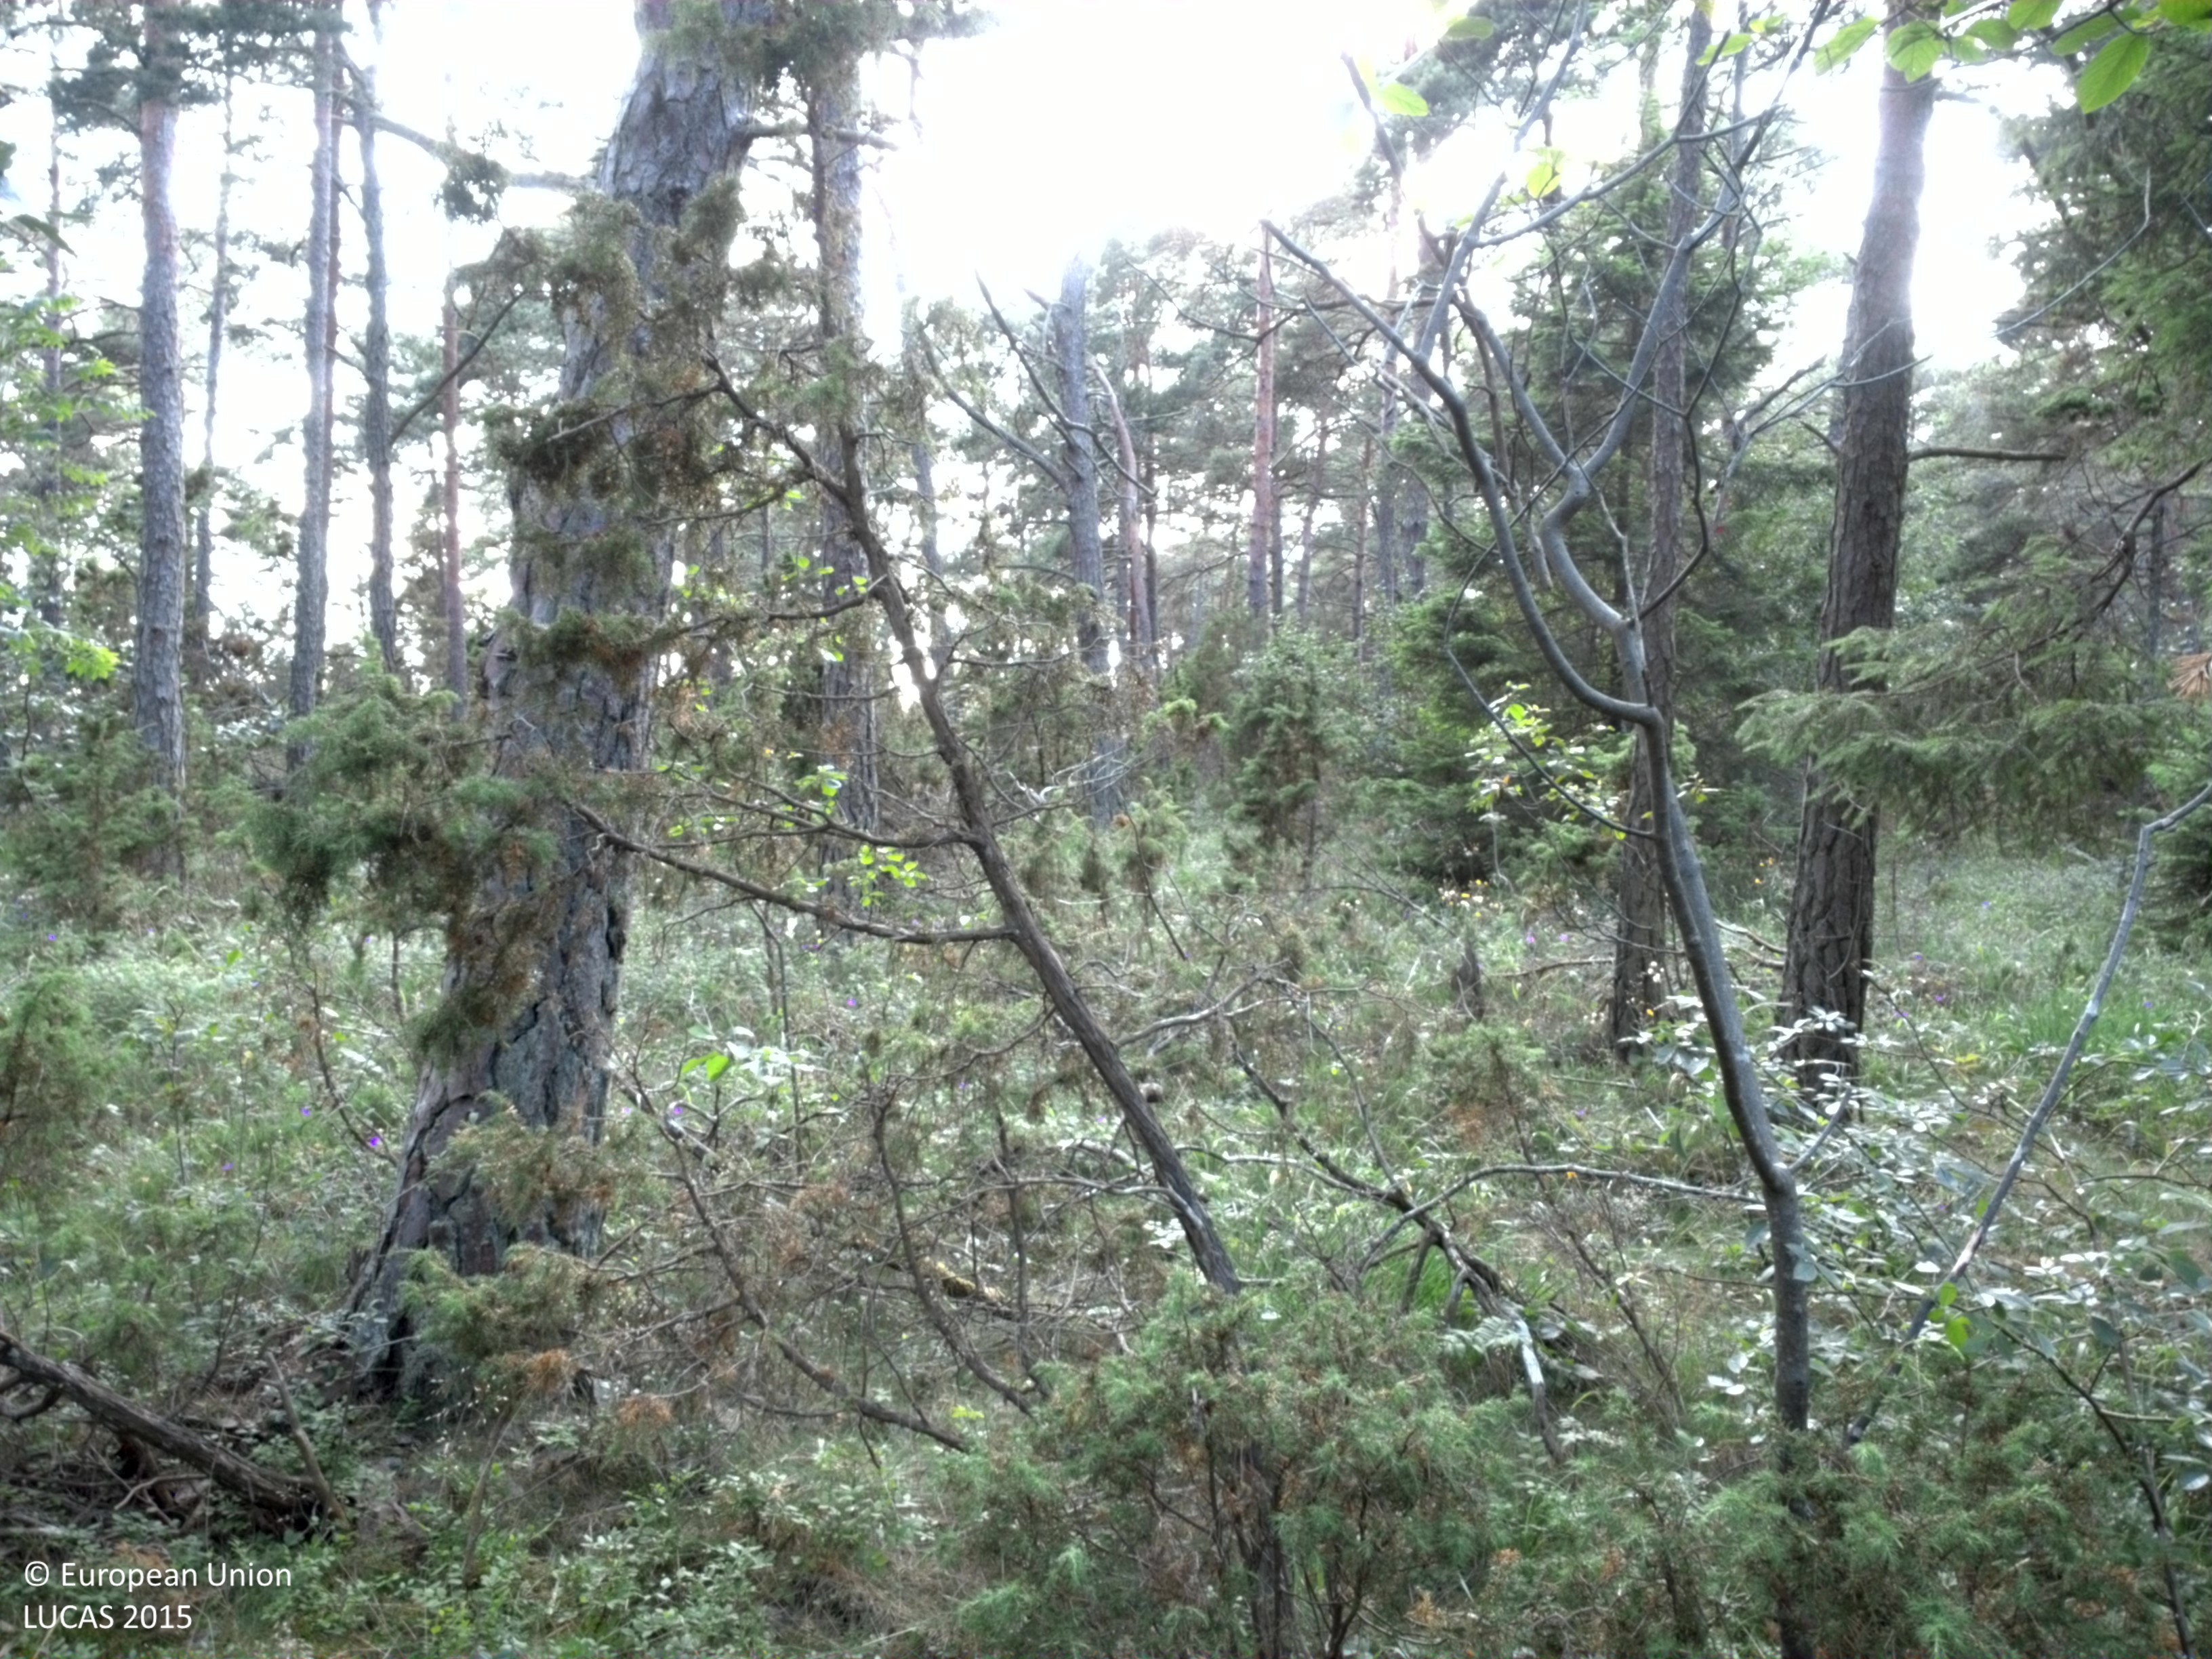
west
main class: Woodland
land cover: Pine dominated coniferous woodland
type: hemiboreal forest and nemoral coniferous forest and mixed broadleaved-coniferous forest
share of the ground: > 75 %
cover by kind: coniferous forest trees 75 %, shrubs 10 %, herbaceous plants 10 %, lichens and mosses 5 %
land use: Forestry
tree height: > 5 m
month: July
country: SE
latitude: 57.5657
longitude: 18.2821
